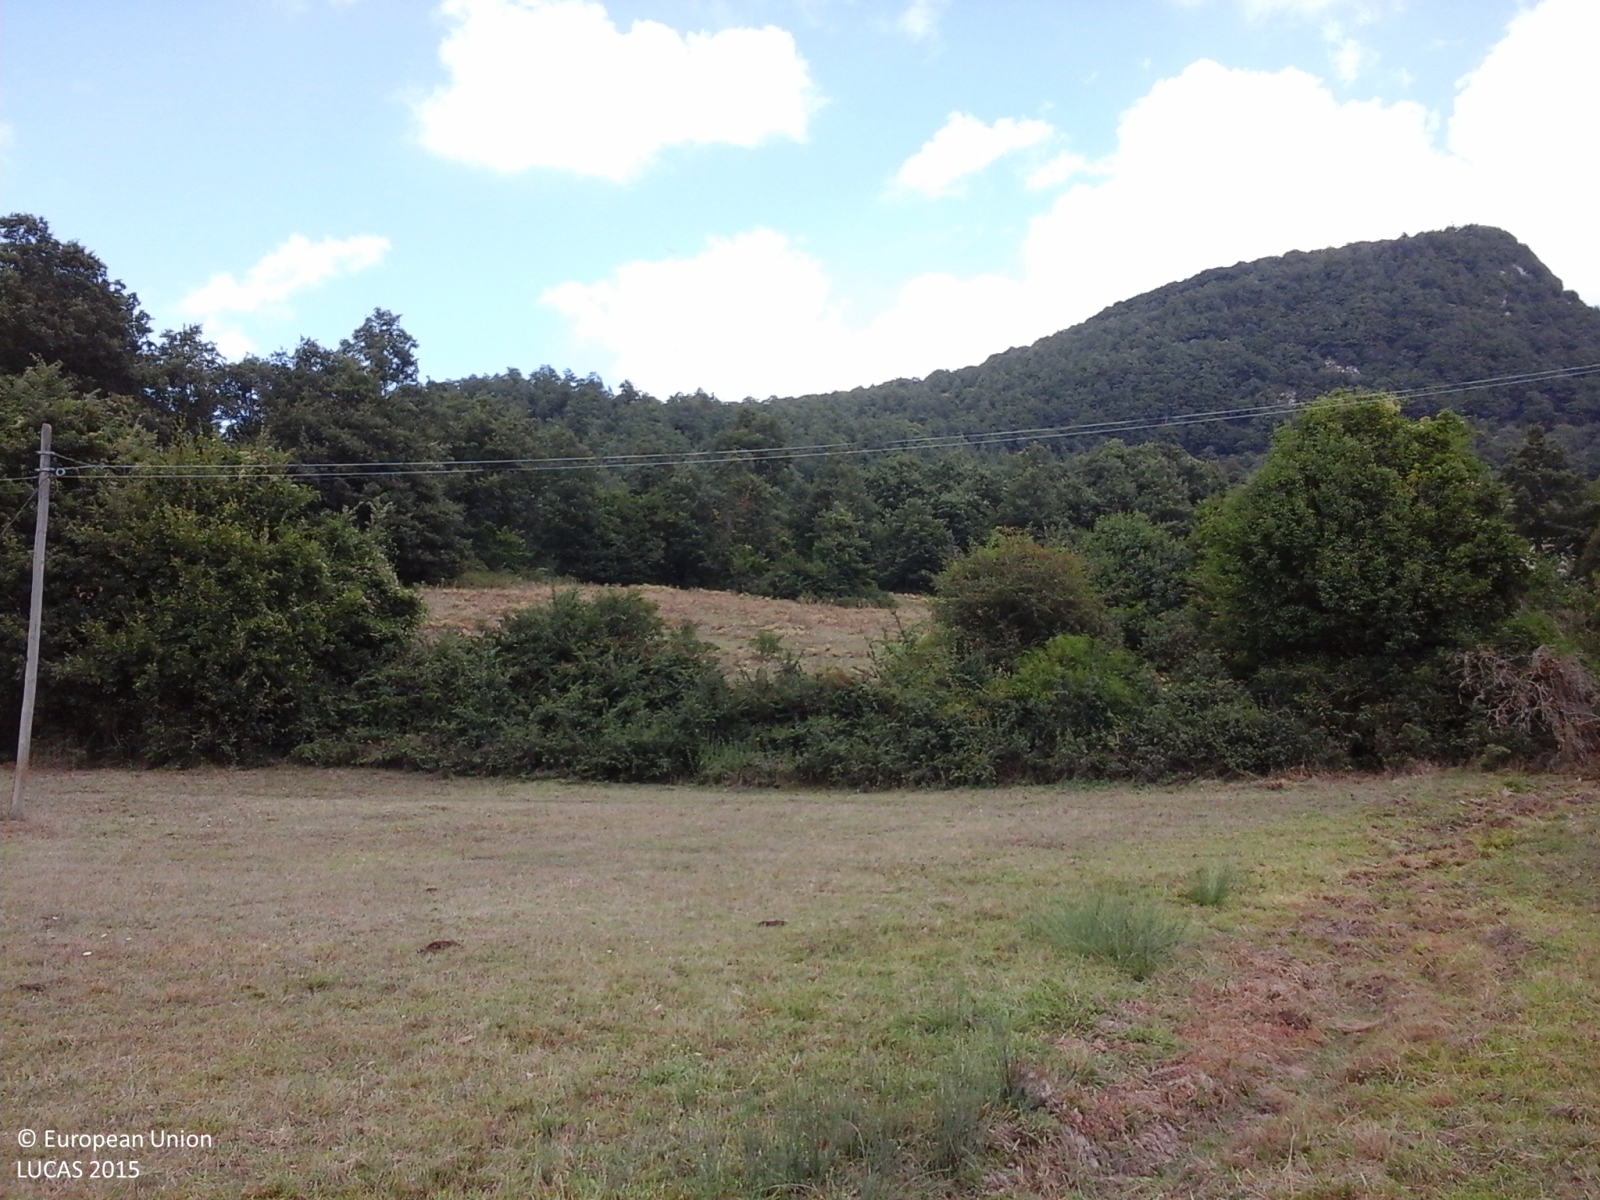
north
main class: Grassland
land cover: Grassland without tree/shrub cover
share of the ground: > 75 %
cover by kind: herbaceous plants 100 %
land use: Agriculture (excluding fallow land and kitchen gardens)
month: August
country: IT
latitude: 41.7707
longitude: 14.2079
